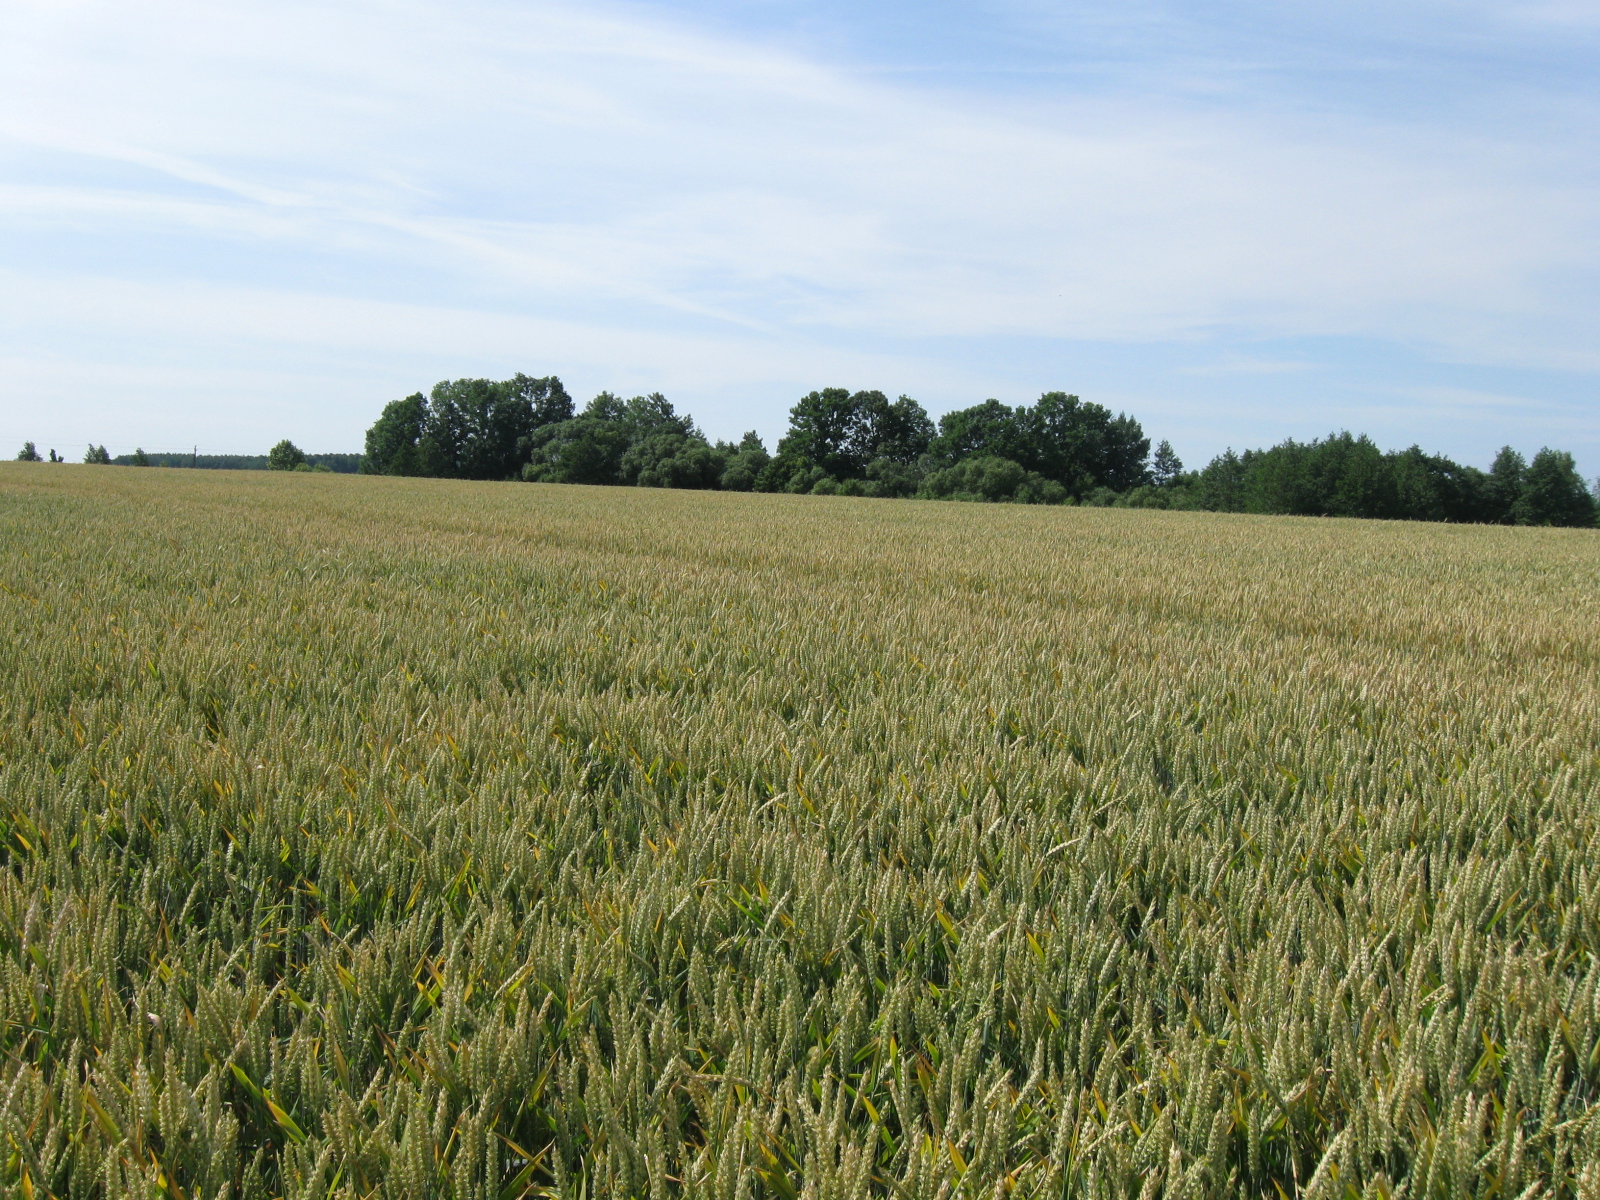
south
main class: Cropland
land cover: Common wheat
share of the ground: > 75 %
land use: Agriculture (excluding fallow land and kitchen gardens)
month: July
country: LT
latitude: 54.7499
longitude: 23.9013
